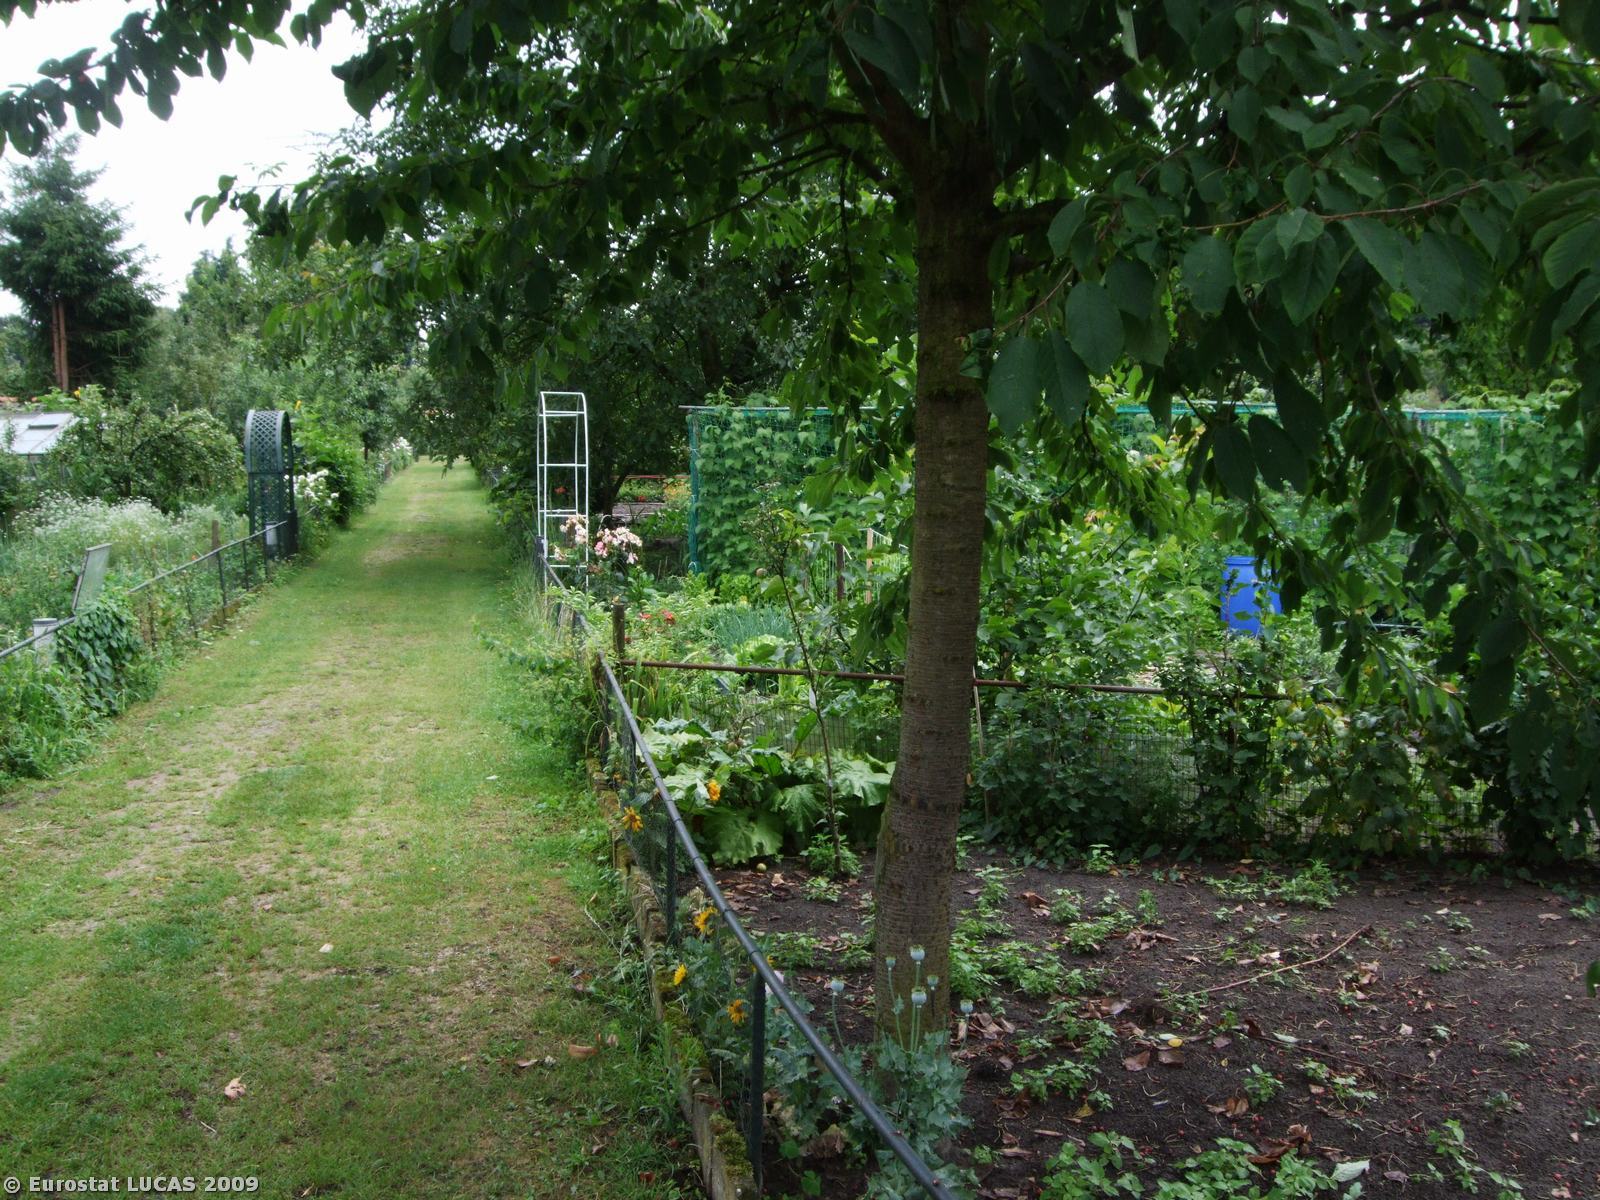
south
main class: Artificial land
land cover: Buildings with 1 to 3 floors
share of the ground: 10 - 25 %
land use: Amenities, museums, leisure
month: July
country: NL
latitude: 51.4714
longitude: 5.6940
